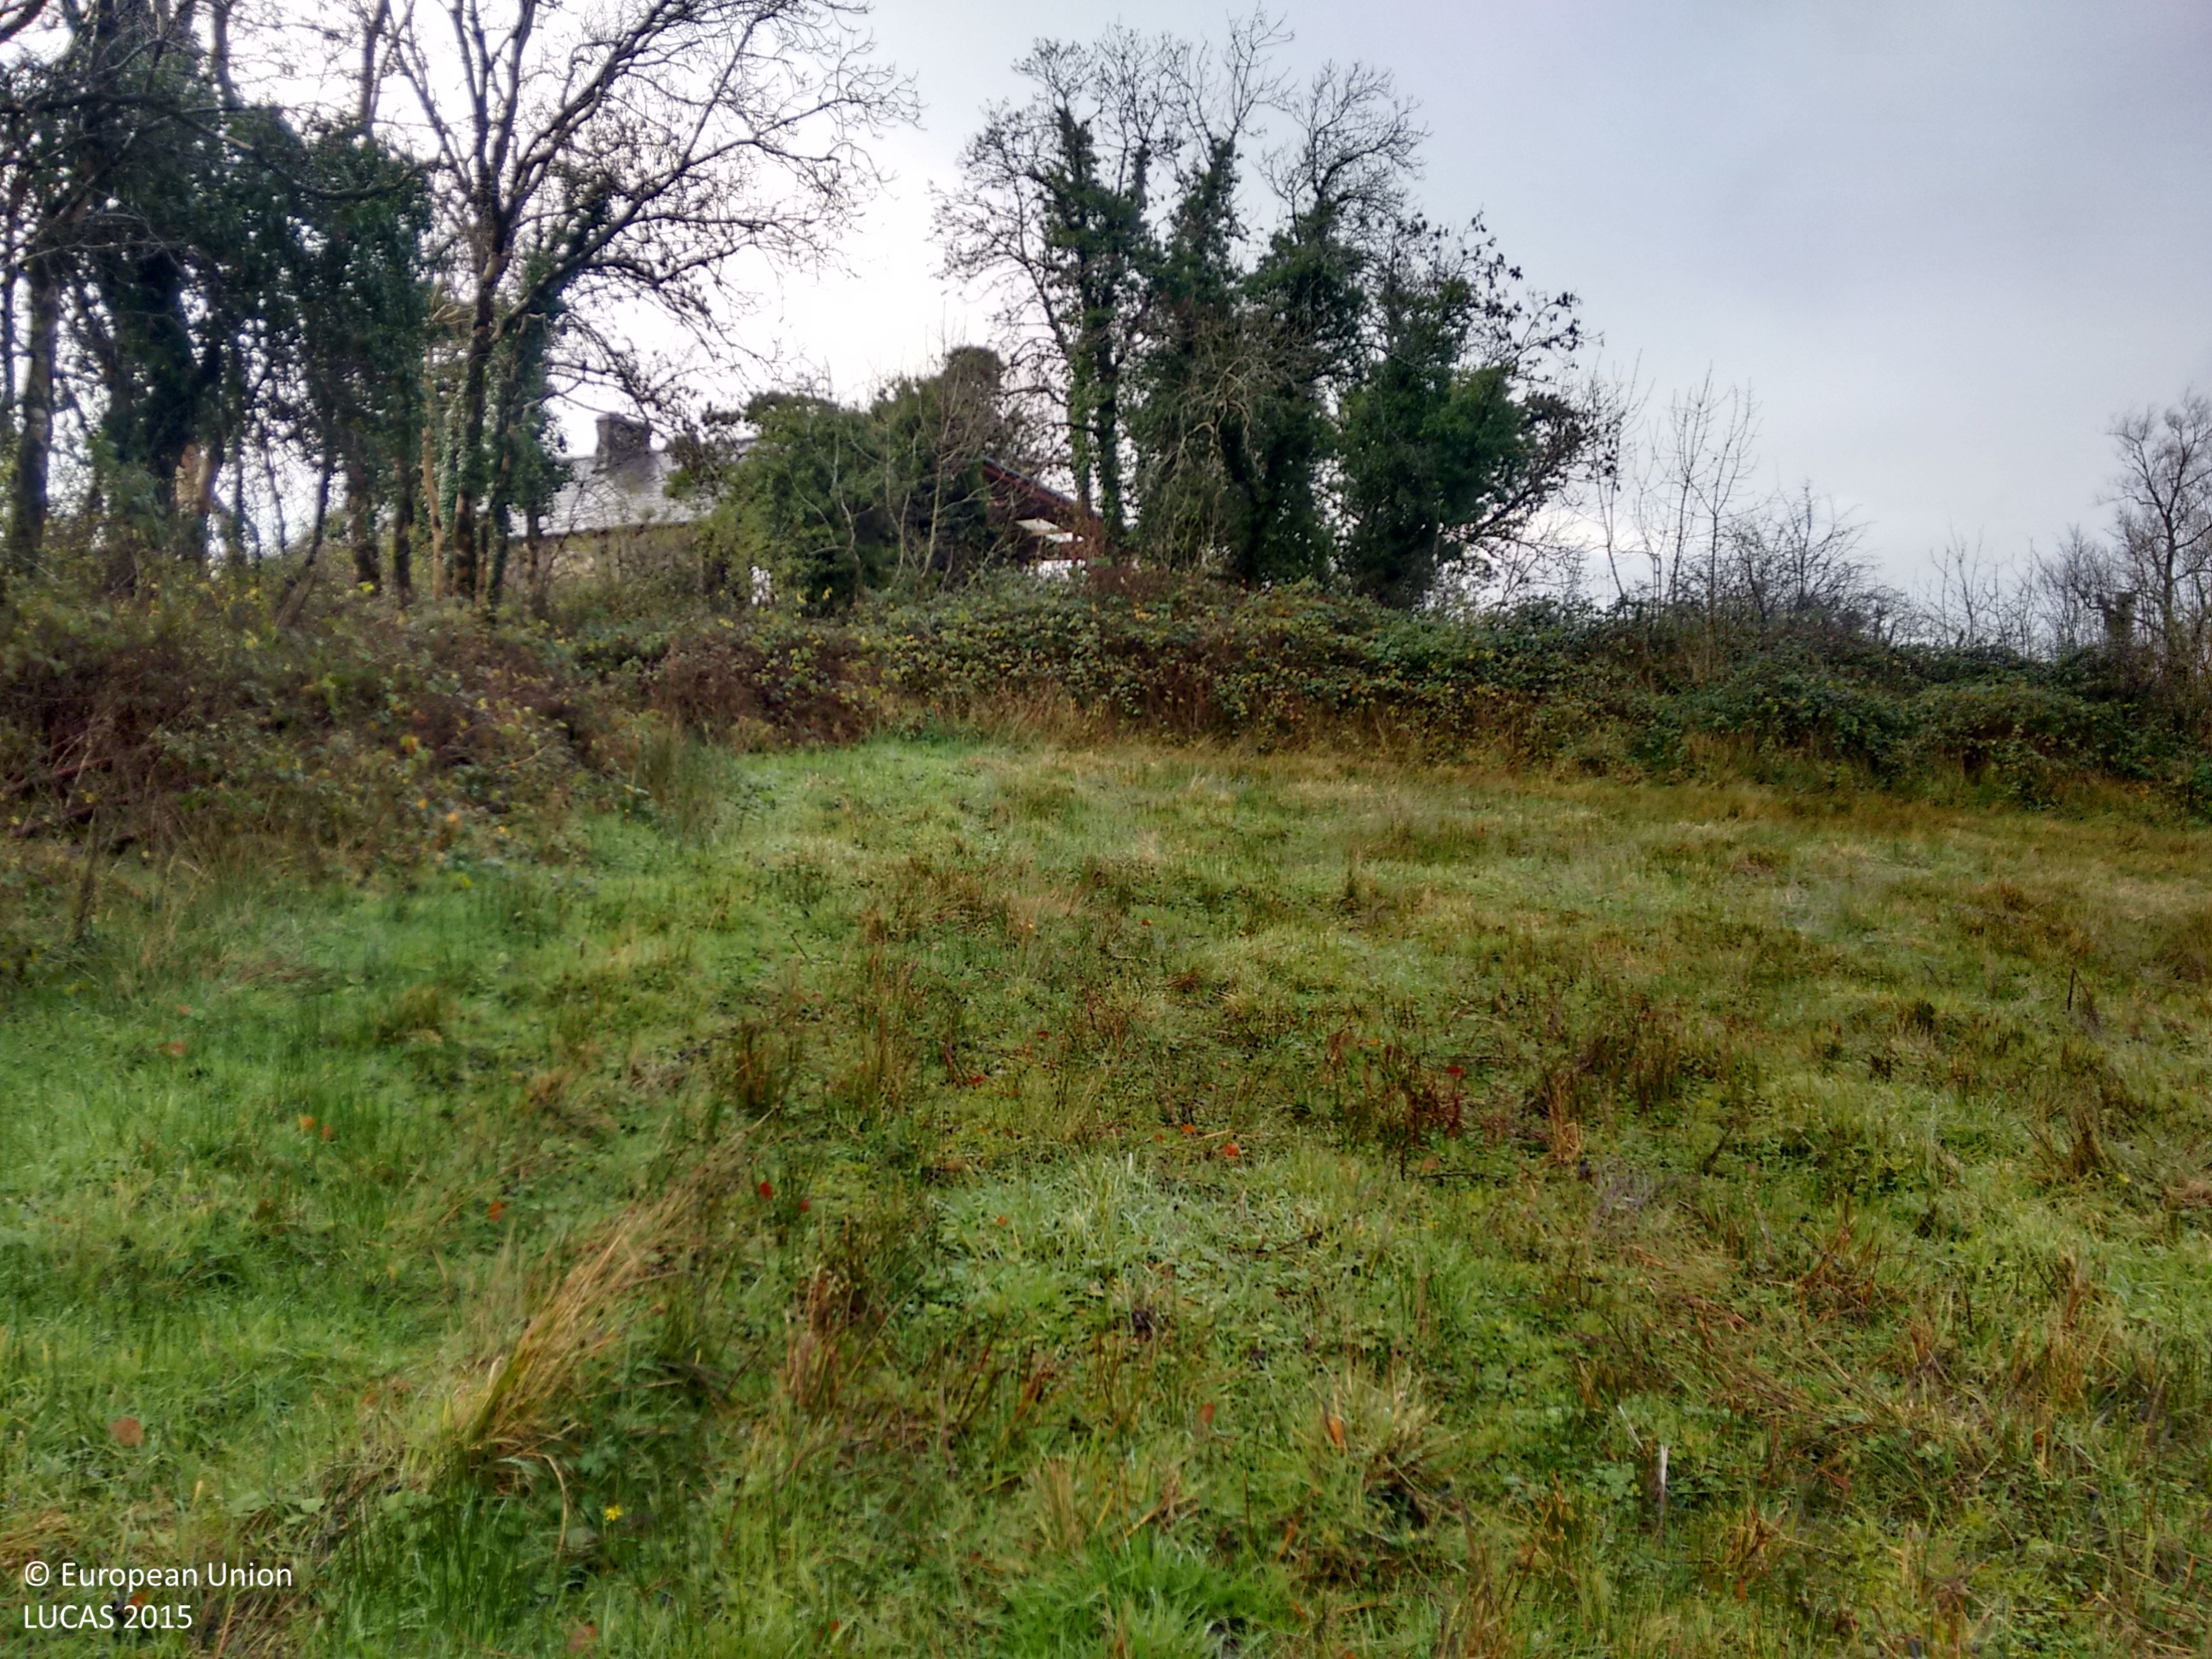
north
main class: Grassland
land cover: Grassland without tree/shrub cover
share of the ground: > 75 %
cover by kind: herbaceous plants 95 %, unconsolidated bare surface 5 %
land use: Agriculture (excluding fallow land and kitchen gardens)
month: November
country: IE
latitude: 53.9486
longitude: -8.0489
